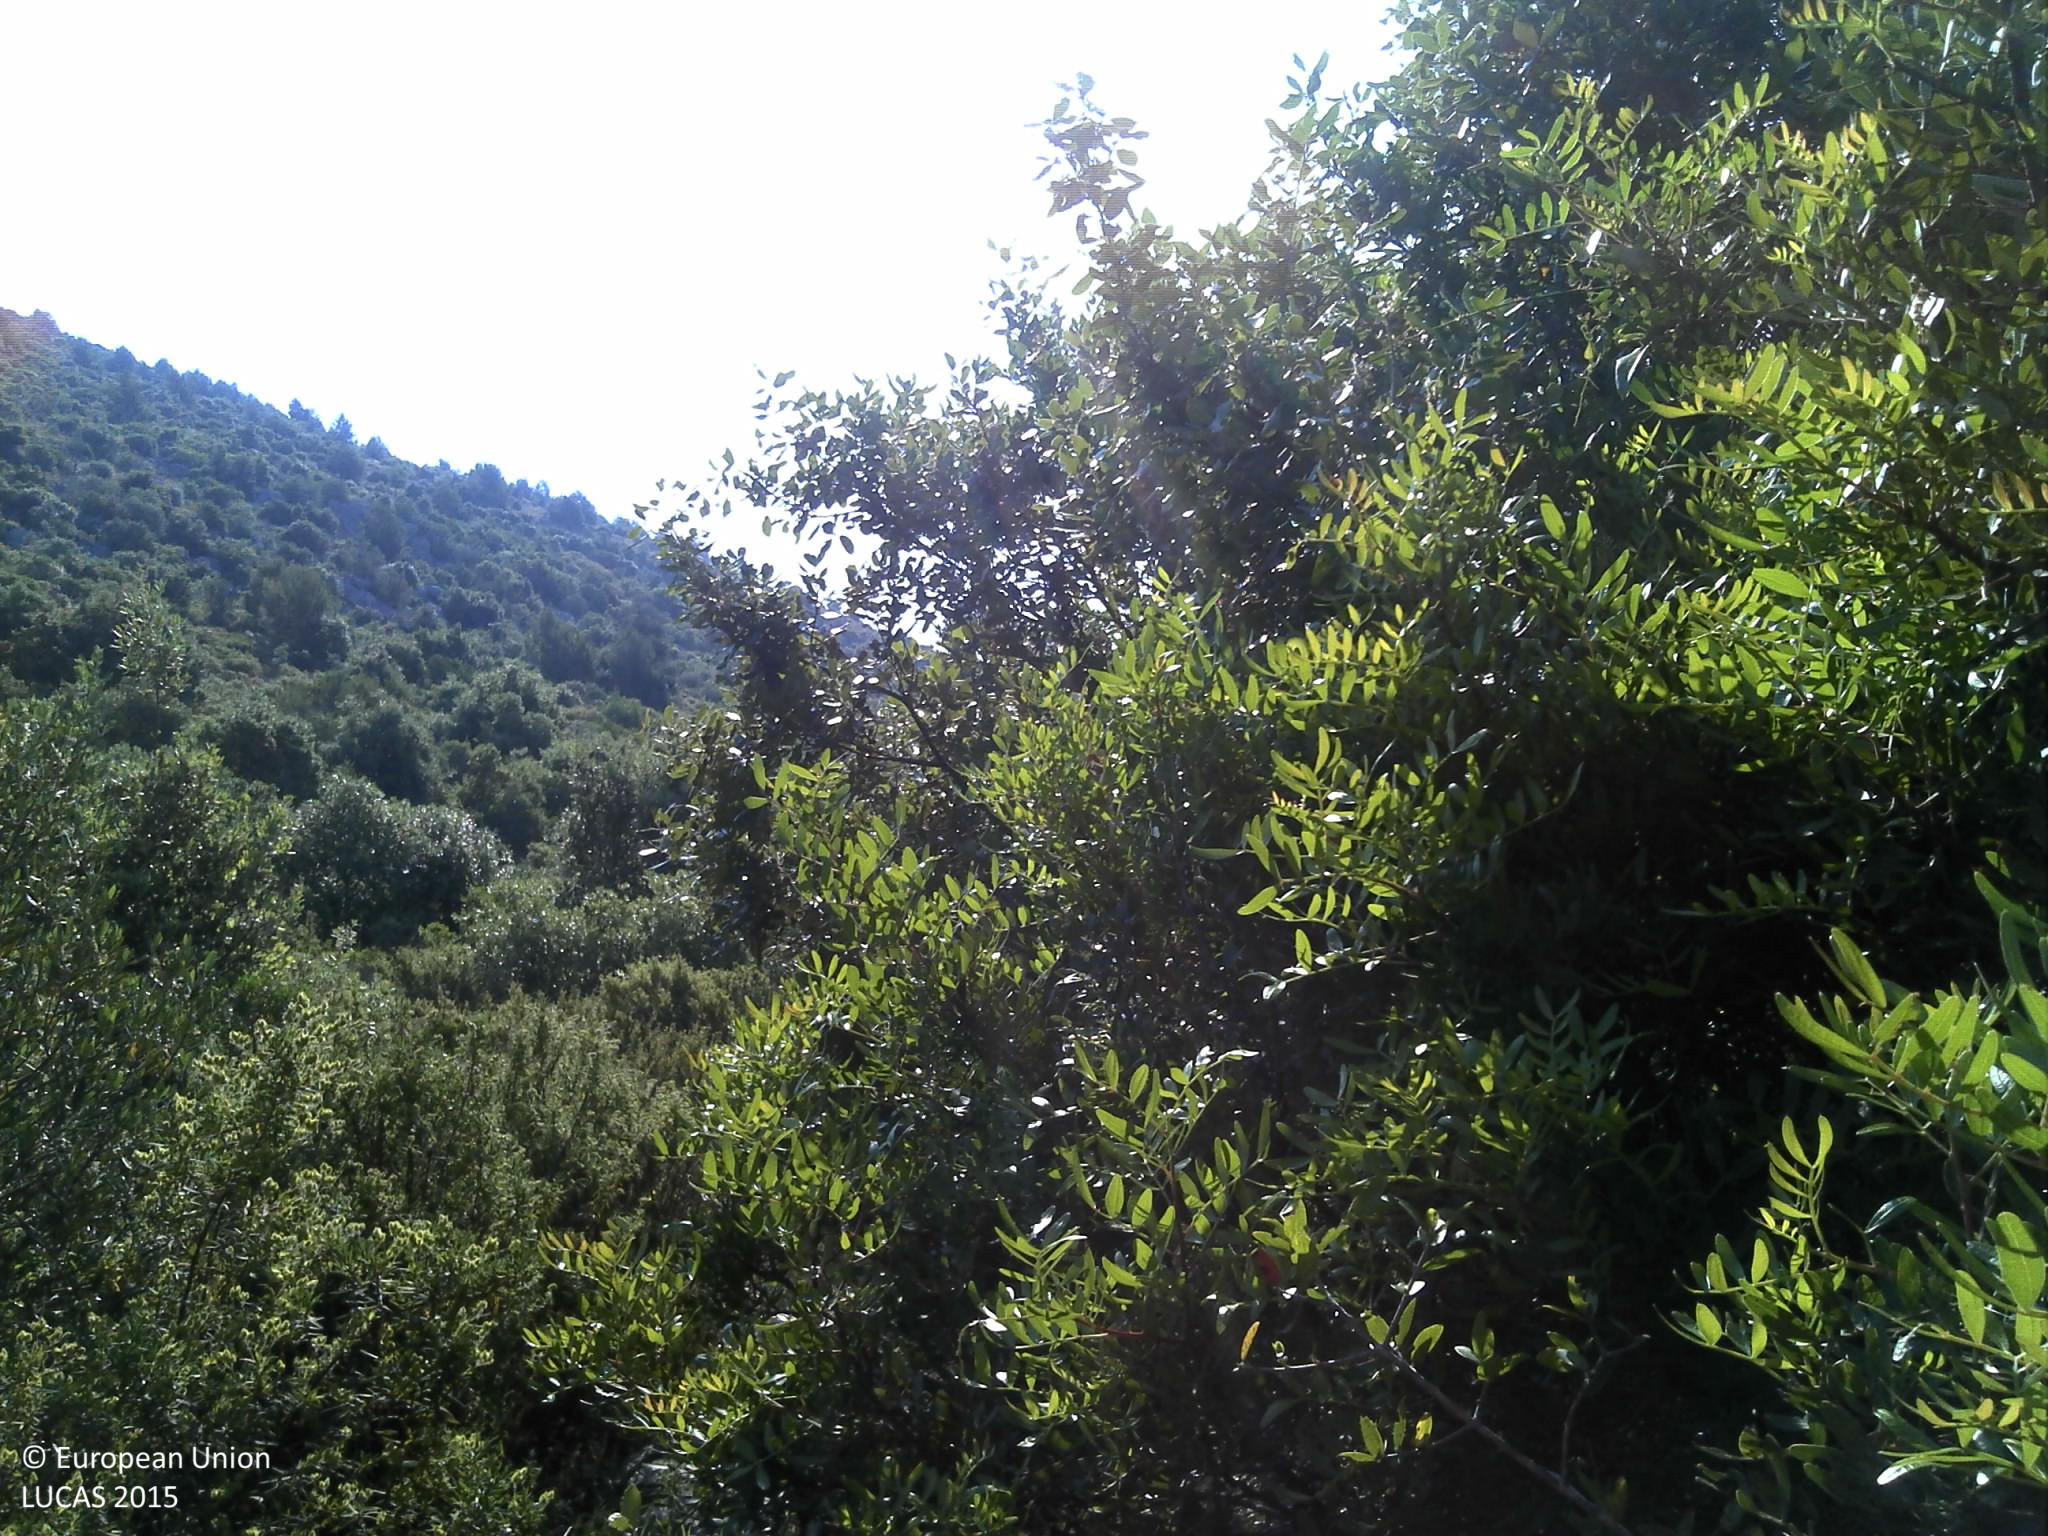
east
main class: Shrubland
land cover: Shrubland with sparse tree cover
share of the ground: > 75 %
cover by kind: shrubs 80 %, coniferous forest trees 5 %, herbaceous plants 5 %, consolidated bare surface 5 %, unconsolidated bare surface 5 %
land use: Semi-natural and natural areas not in use
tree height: < 5 m
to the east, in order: Shrubland with sparse tree cover; Dry stone walls; Shrubland with sparse tree cover; Dry stone walls; Shrubland with sparse tree cover; Dry stone walls; Shrubland with sparse tree cover; Dry stone walls; Shrubland with sparse tree cover
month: June
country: HR
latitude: 43.5220
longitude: 16.0650
